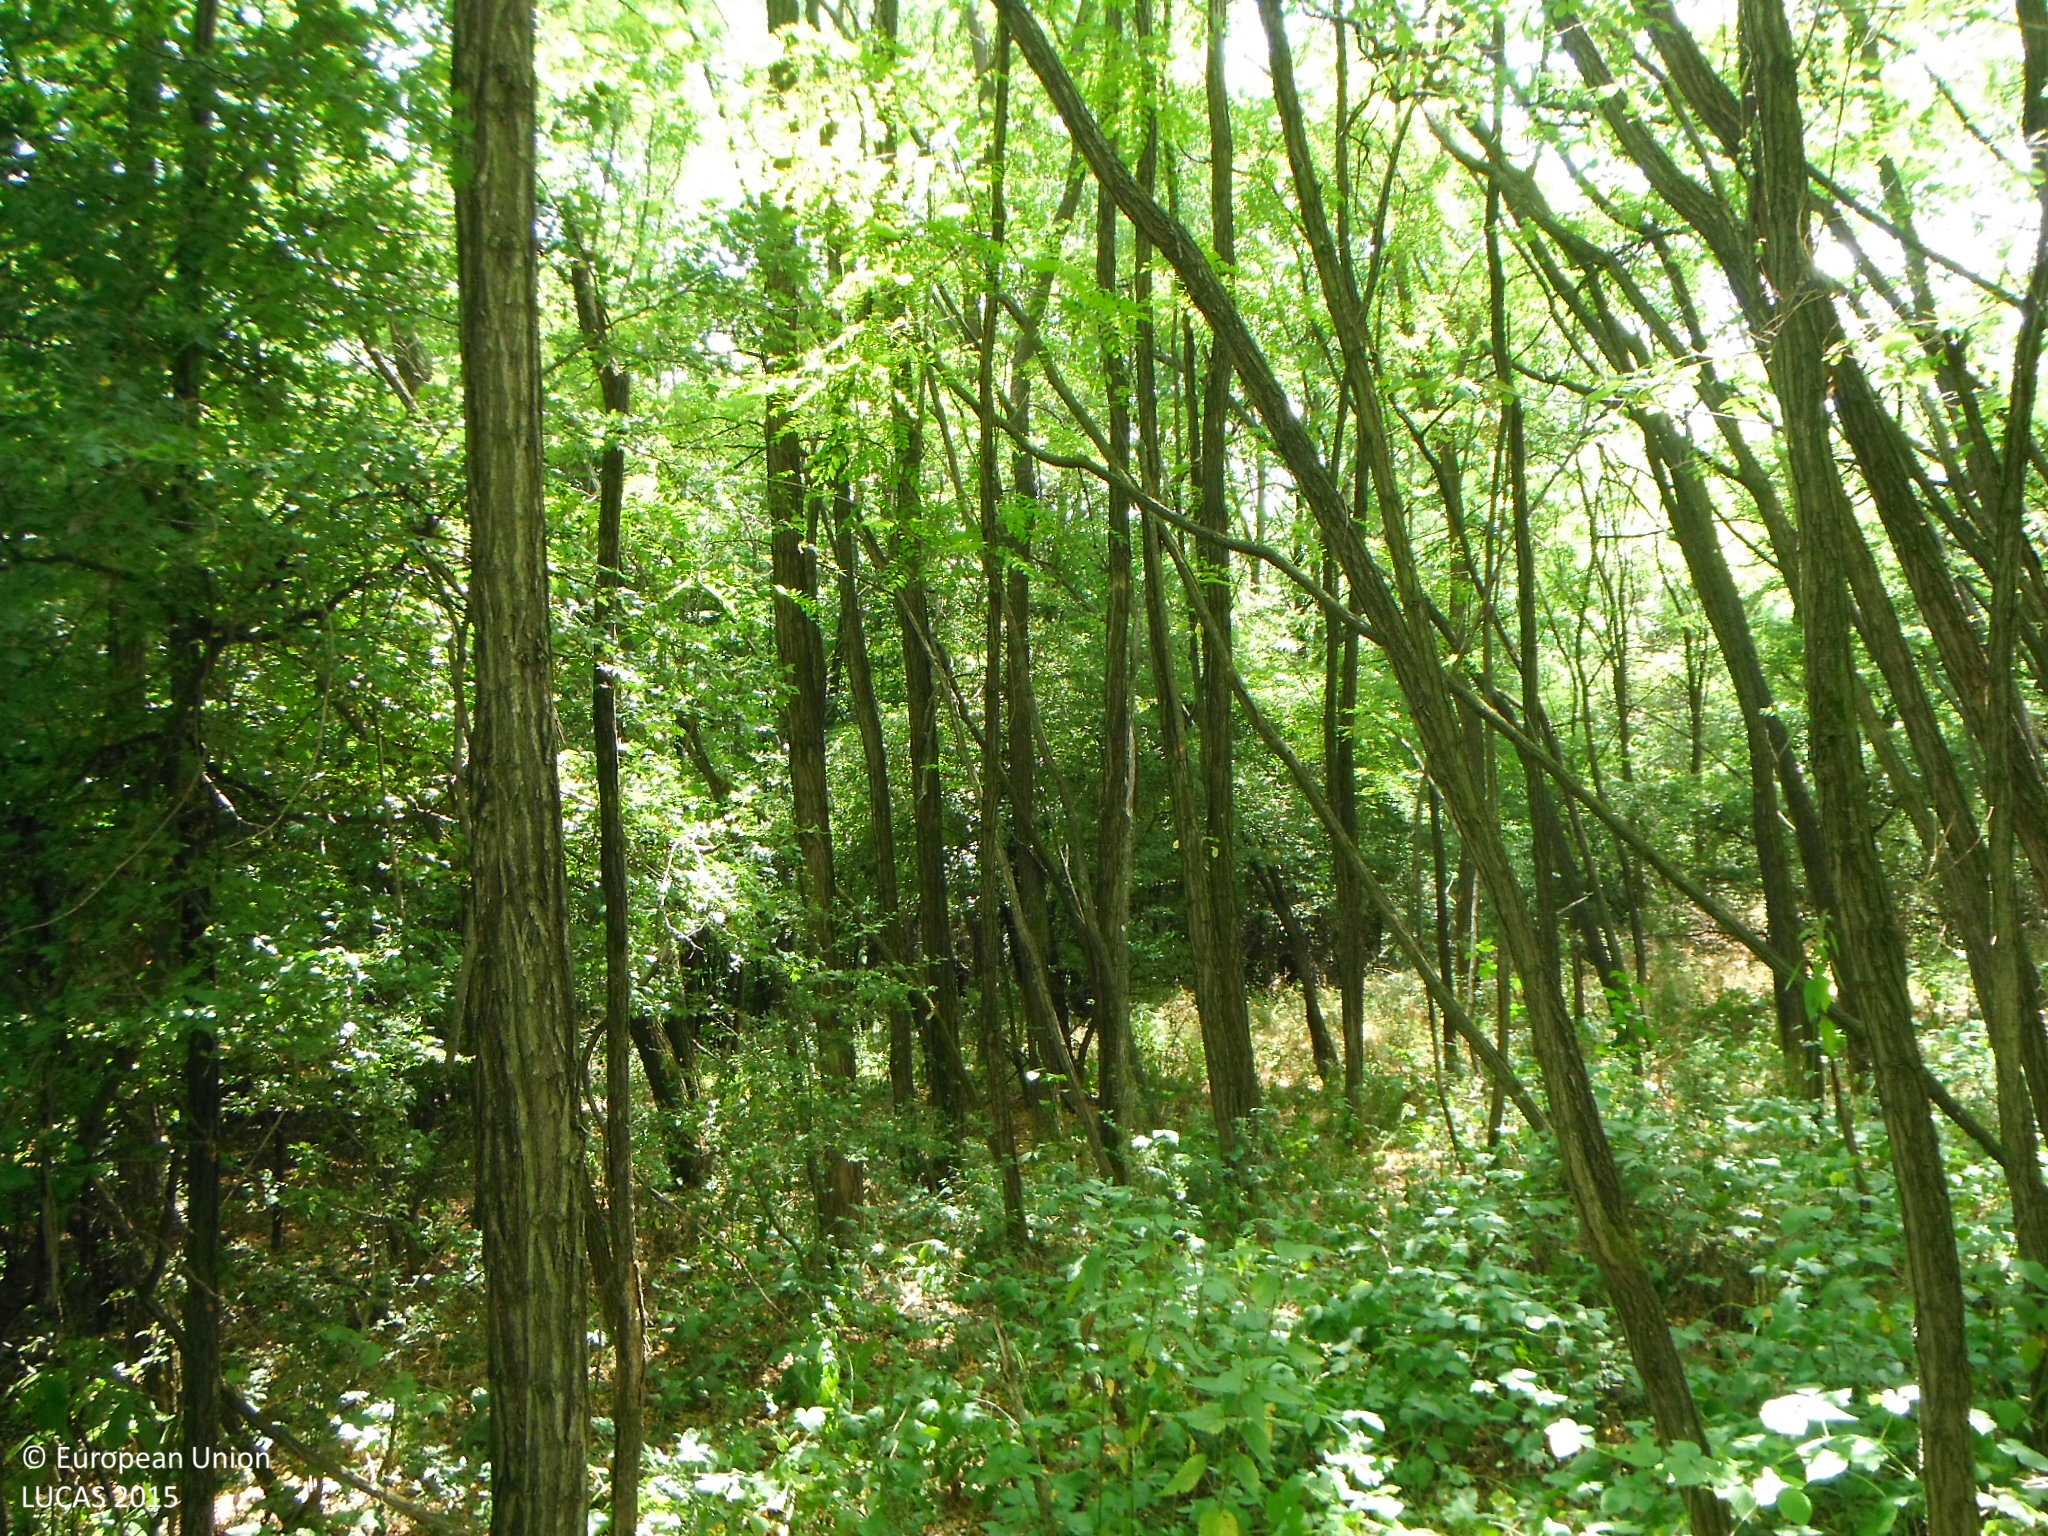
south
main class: Woodland
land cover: Broadleaved woodland
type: mesophytic deciduous forest
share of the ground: > 75 %
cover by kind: broadleaved forest trees 100 %
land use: Forestry
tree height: > 5 m
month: July
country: SK
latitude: 48.2596
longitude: 19.1404
